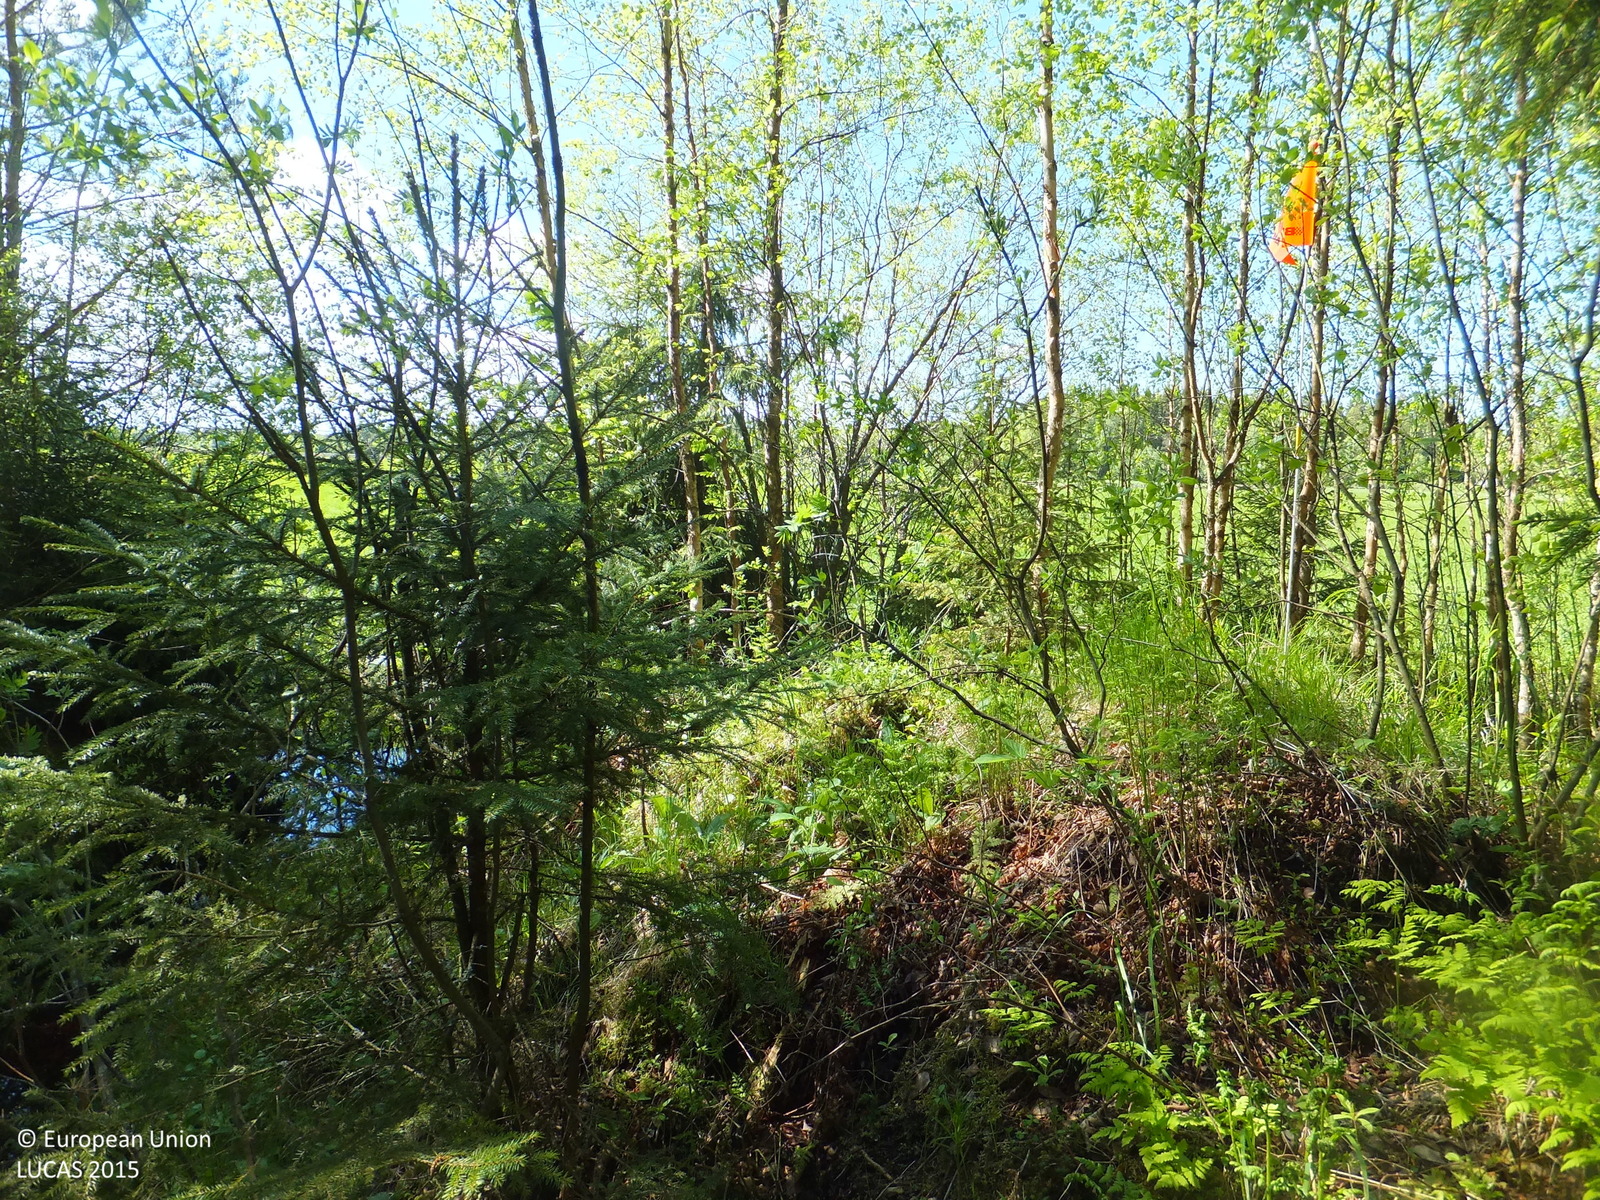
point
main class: Woodland
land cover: Spruce dominated mixed woodland
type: boreal forest
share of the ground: 50 - 75 %
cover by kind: coniferous forest trees 30 %, broadleaved forest trees 30 %, shrubs 20 %, herbaceous plants 10 %, lichens and mosses 10 %
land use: Forestry
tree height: > 5 m
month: June
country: FI
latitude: 63.6445
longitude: 22.9535
